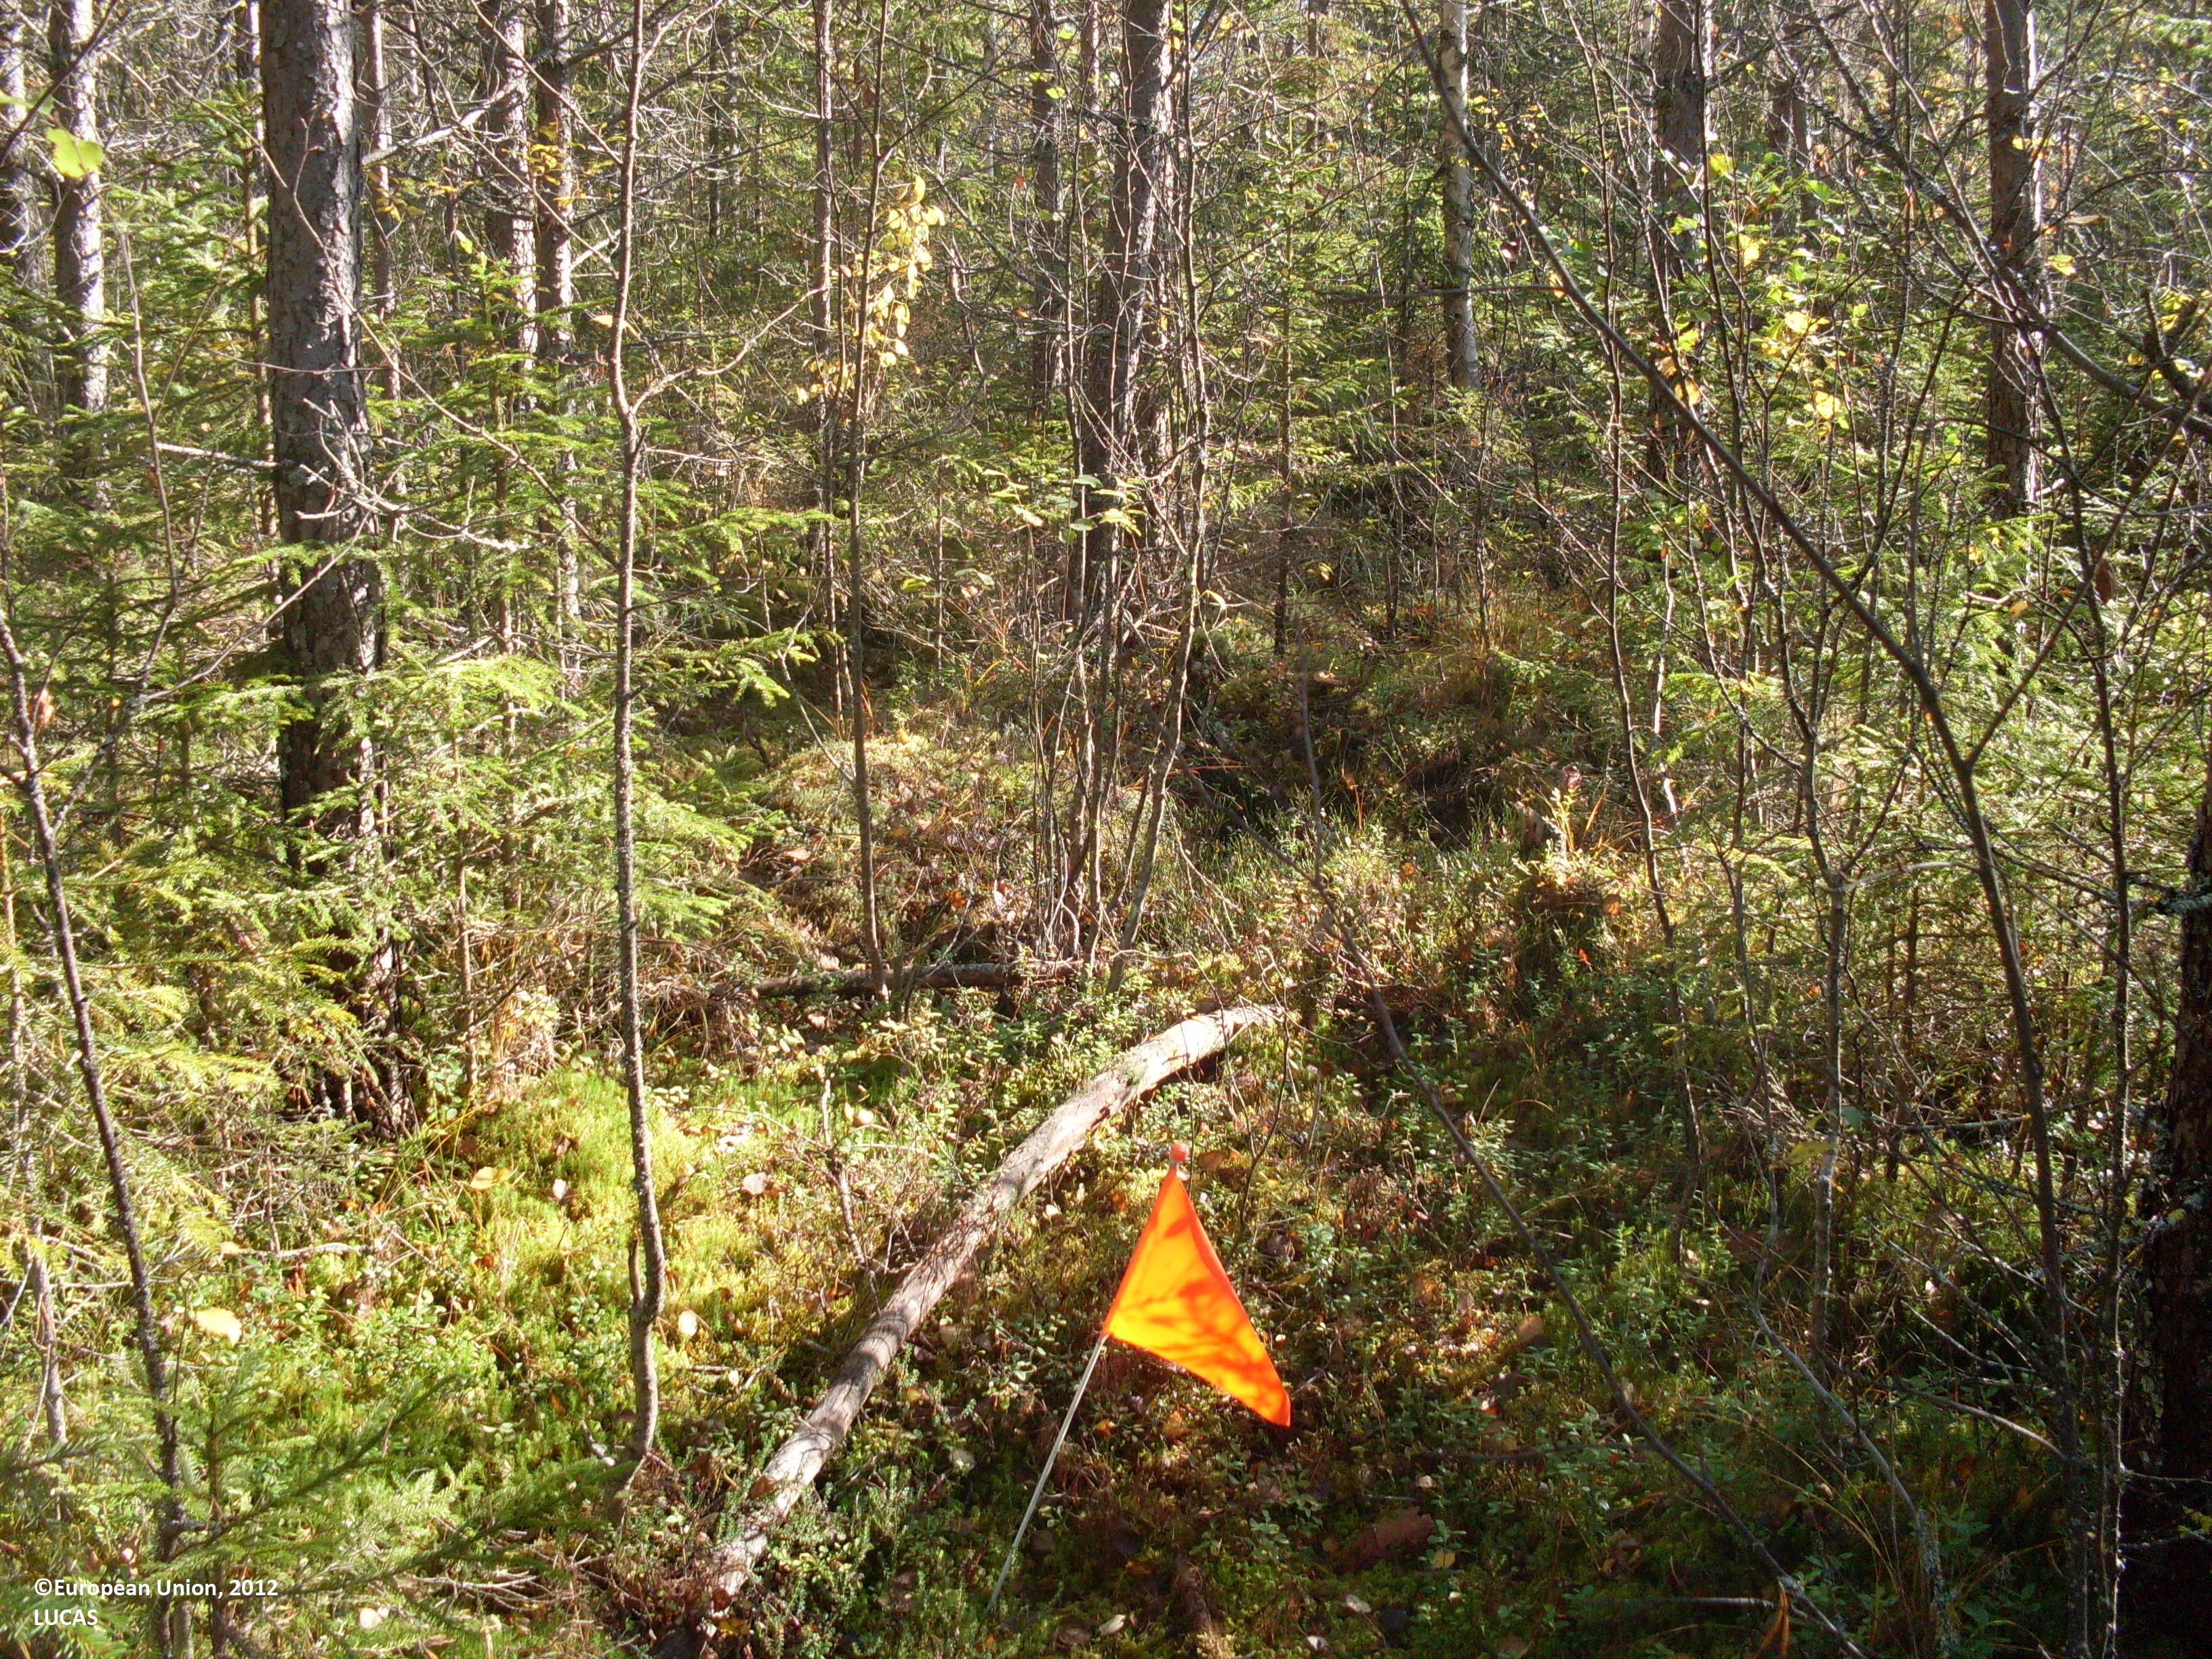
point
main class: Woodland
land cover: Pine dominated mixed woodland
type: boreal forest
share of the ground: > 75 %
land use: Forestry
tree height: > 5 m
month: September
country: FI
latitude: 64.3310
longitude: 28.5752
